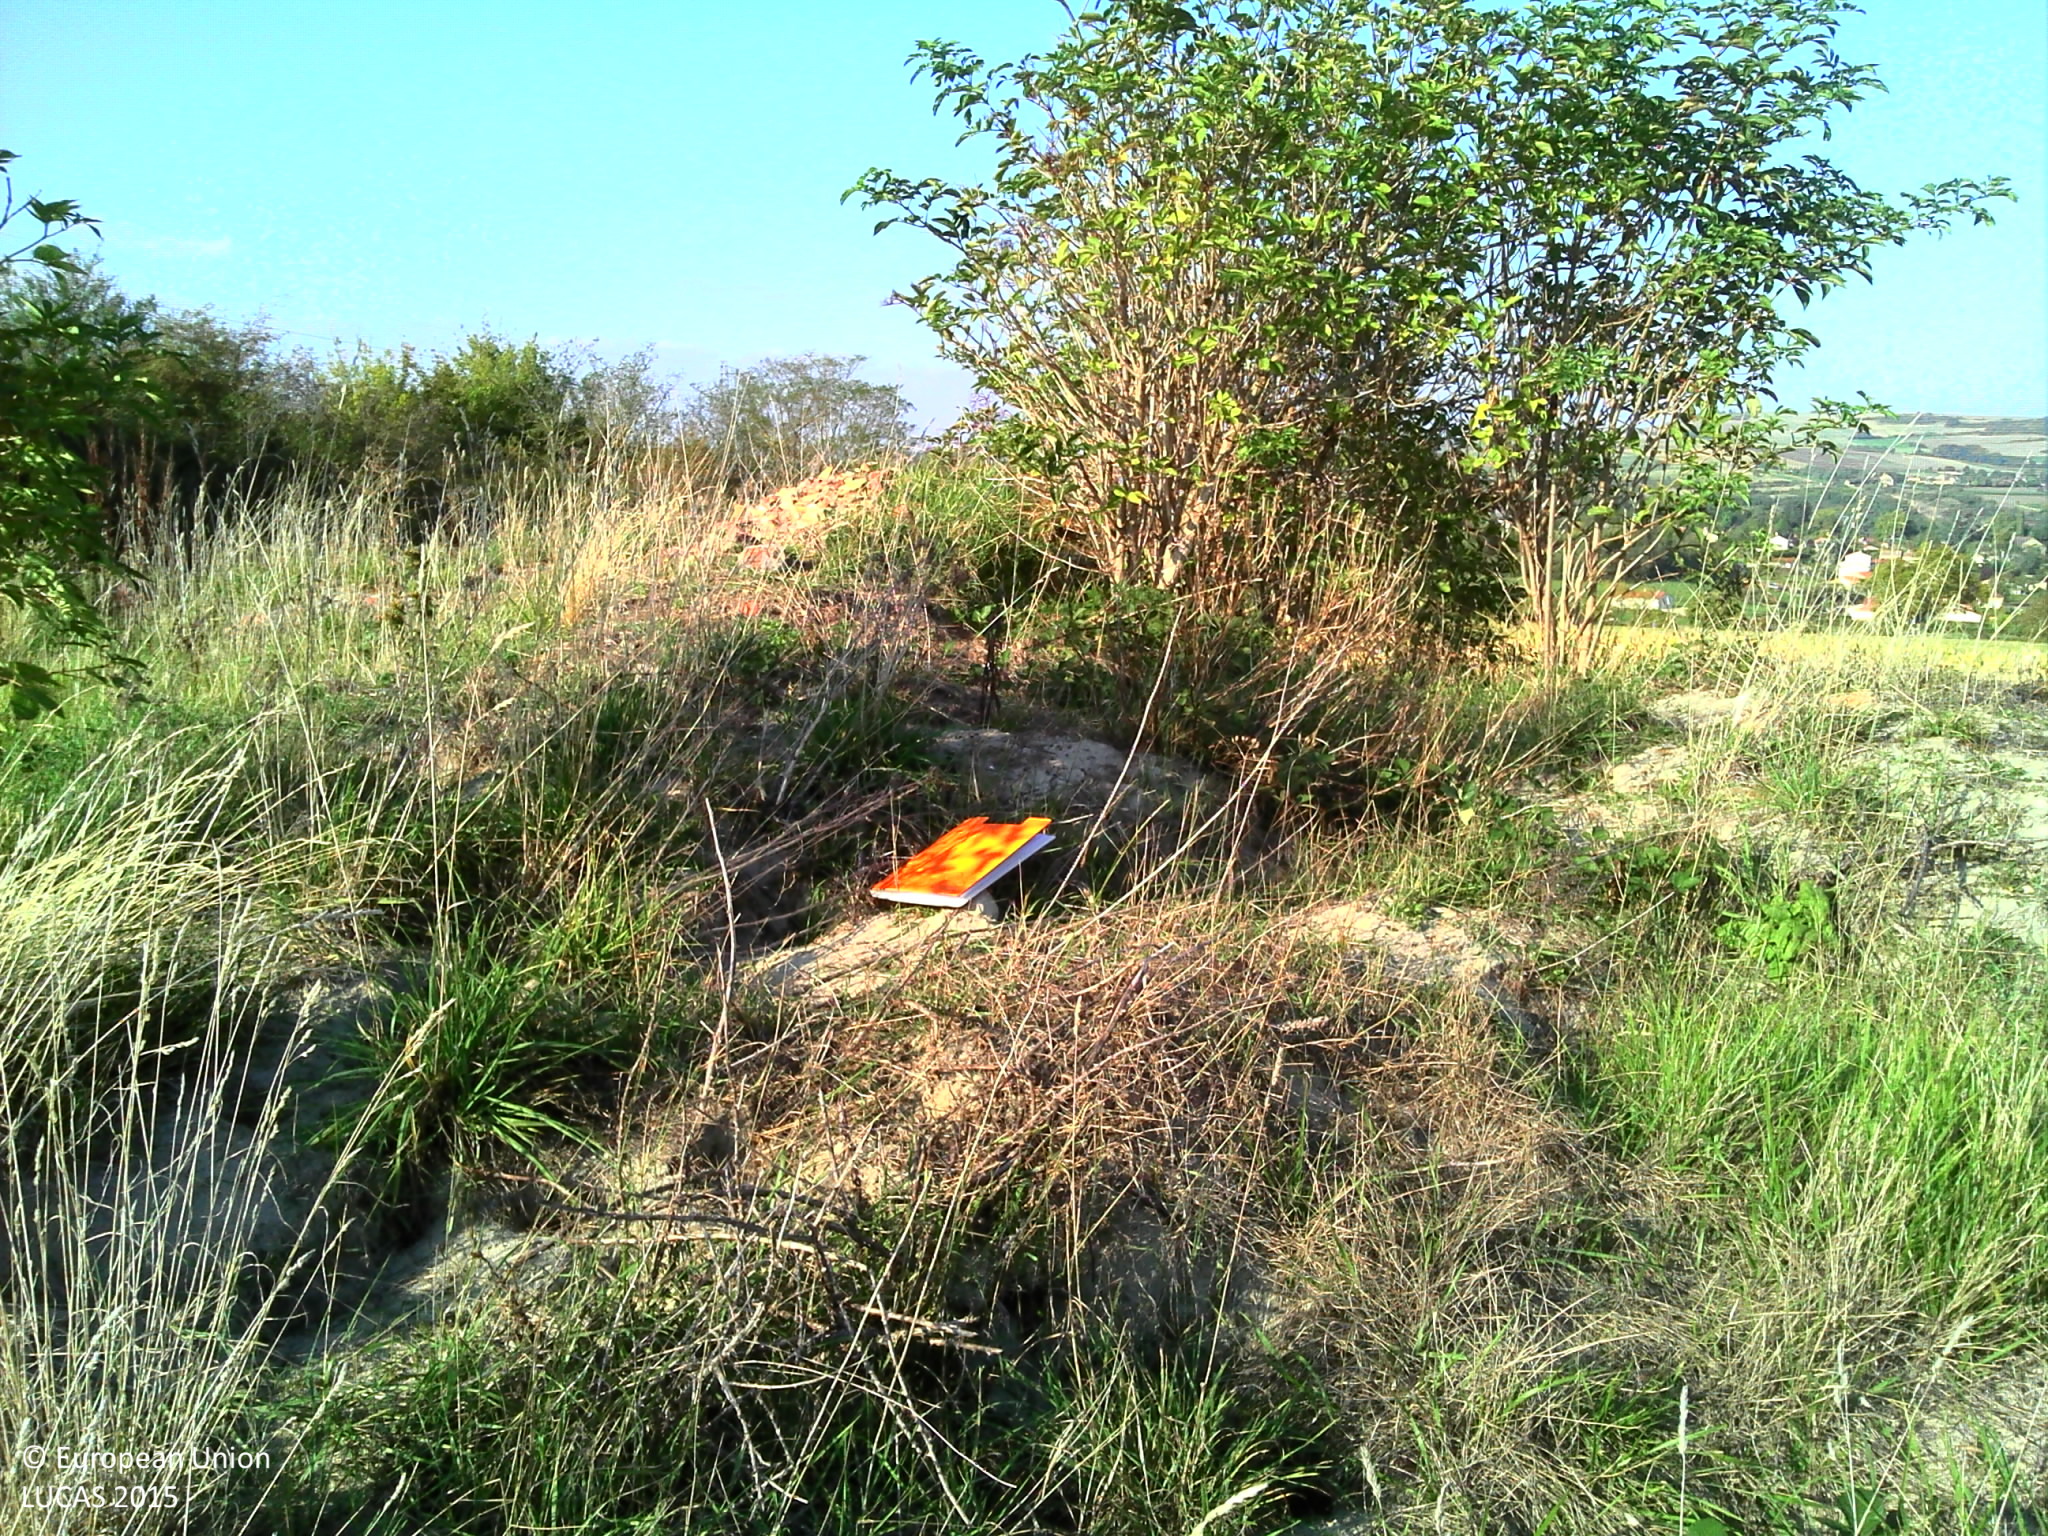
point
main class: Grassland
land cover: Spontaneously vegetated surfaces
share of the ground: 50 - 75 %
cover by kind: herbaceous plants 65 %, unconsolidated bare surface 35 %
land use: Semi-natural and natural areas not in use
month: October
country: FR
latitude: 45.9849
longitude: 3.1187
